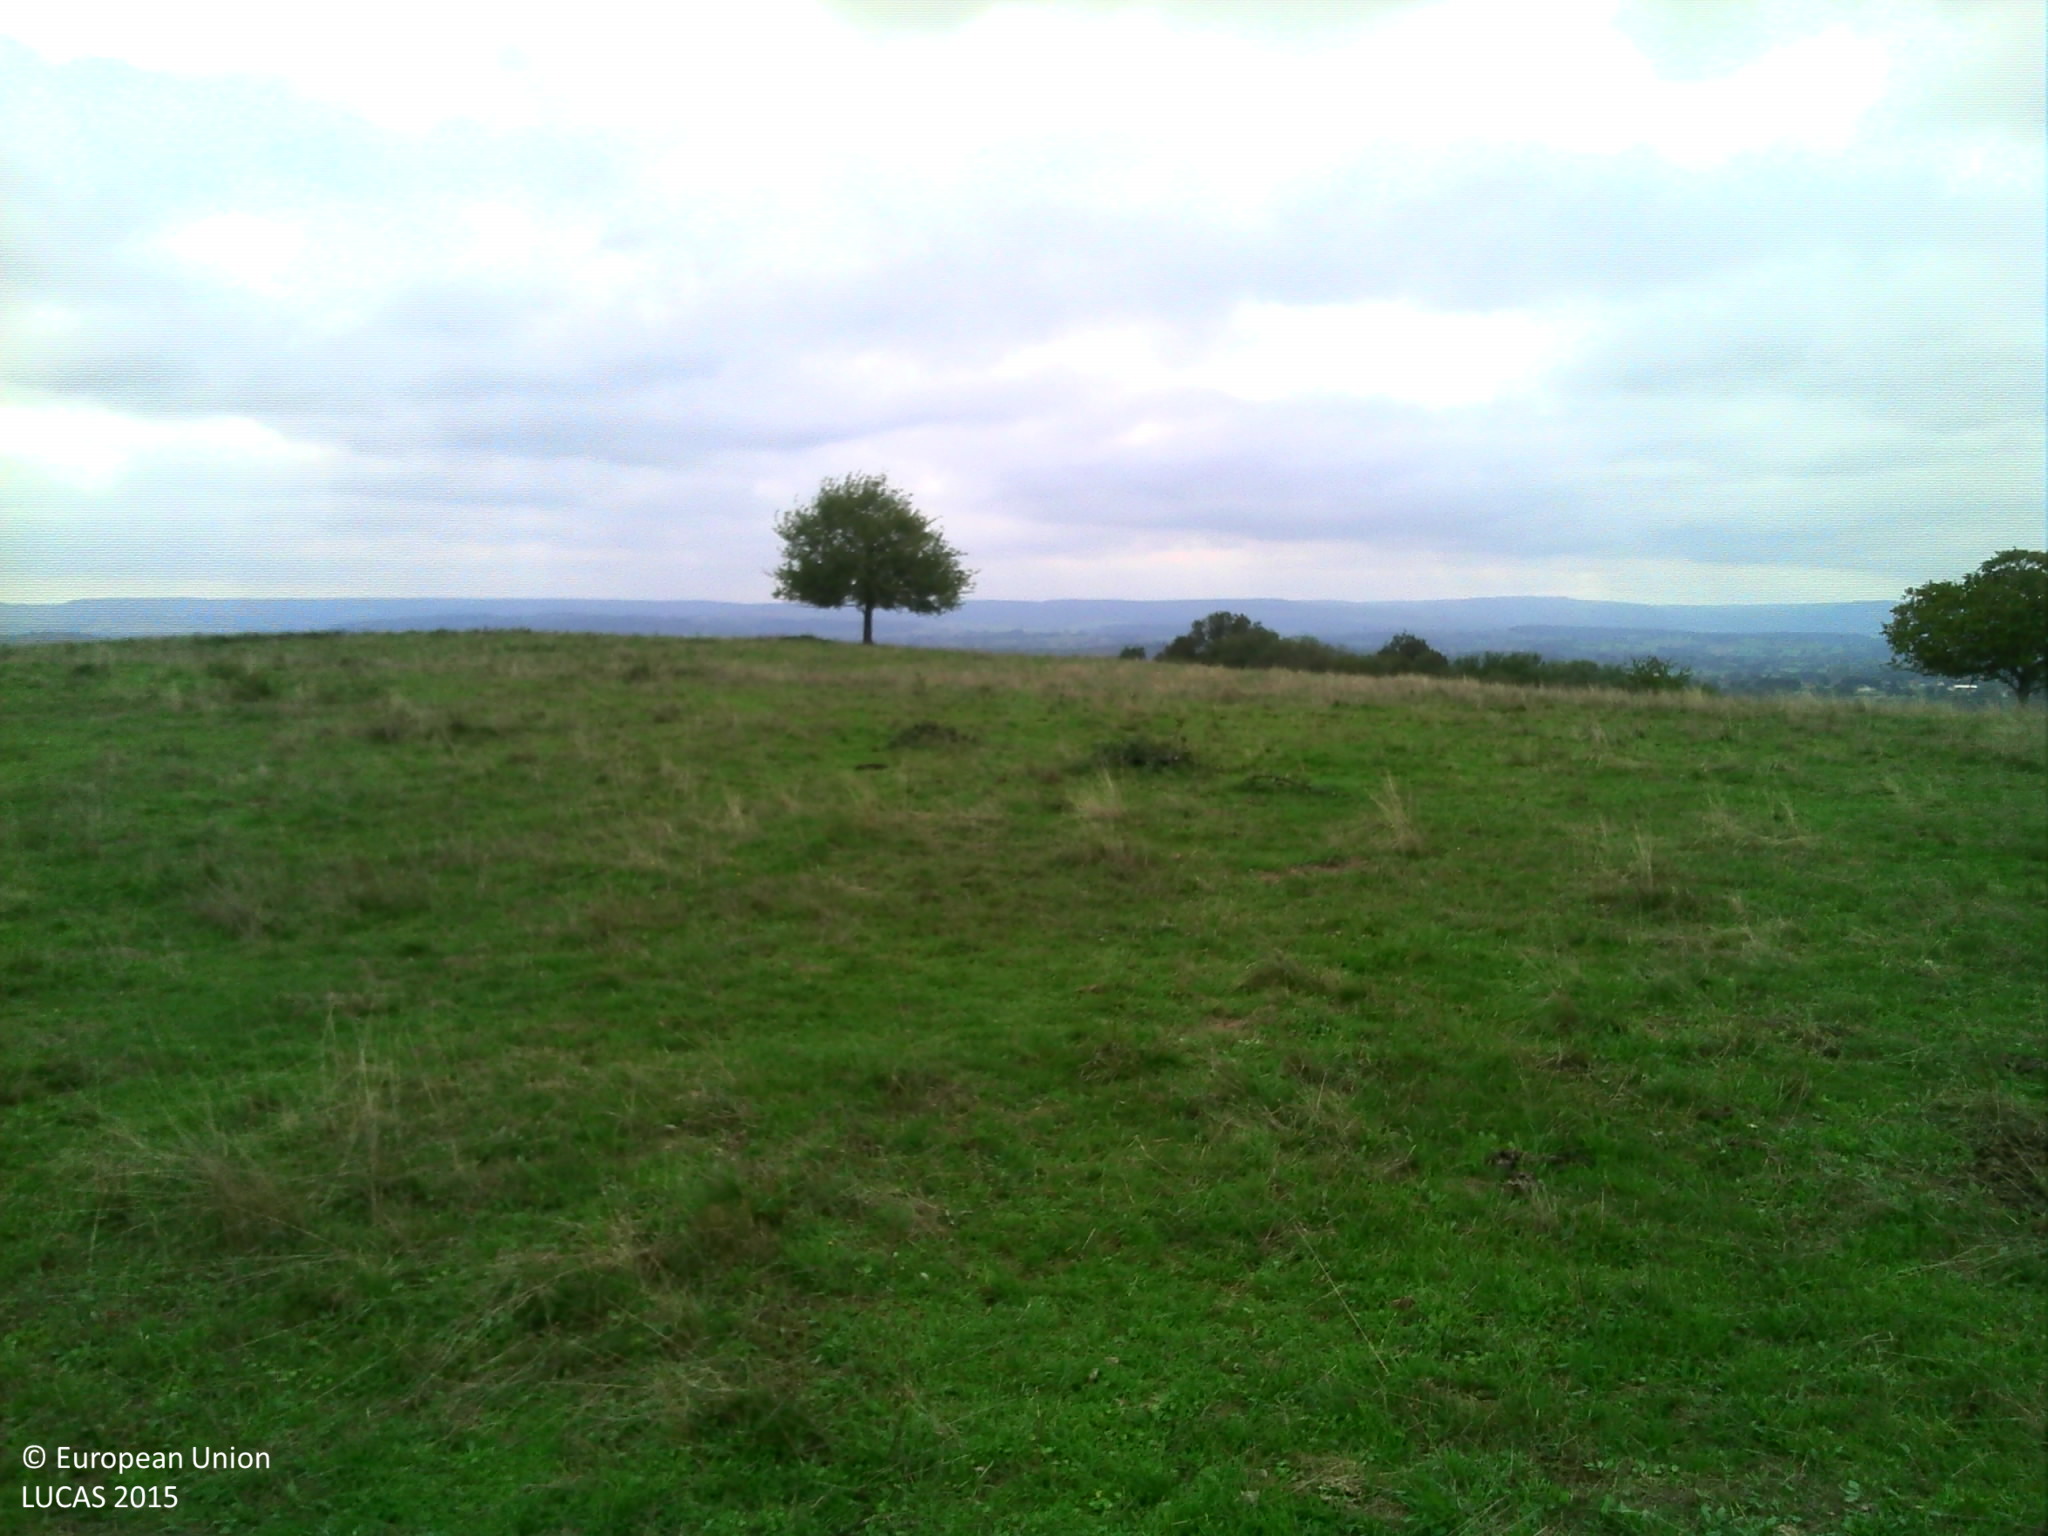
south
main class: Grassland
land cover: Grassland without tree/shrub cover
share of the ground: > 75 %
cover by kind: herbaceous plants 100 %
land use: Agriculture (excluding fallow land and kitchen gardens)
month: September
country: FR
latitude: 47.0683
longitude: 4.3507
